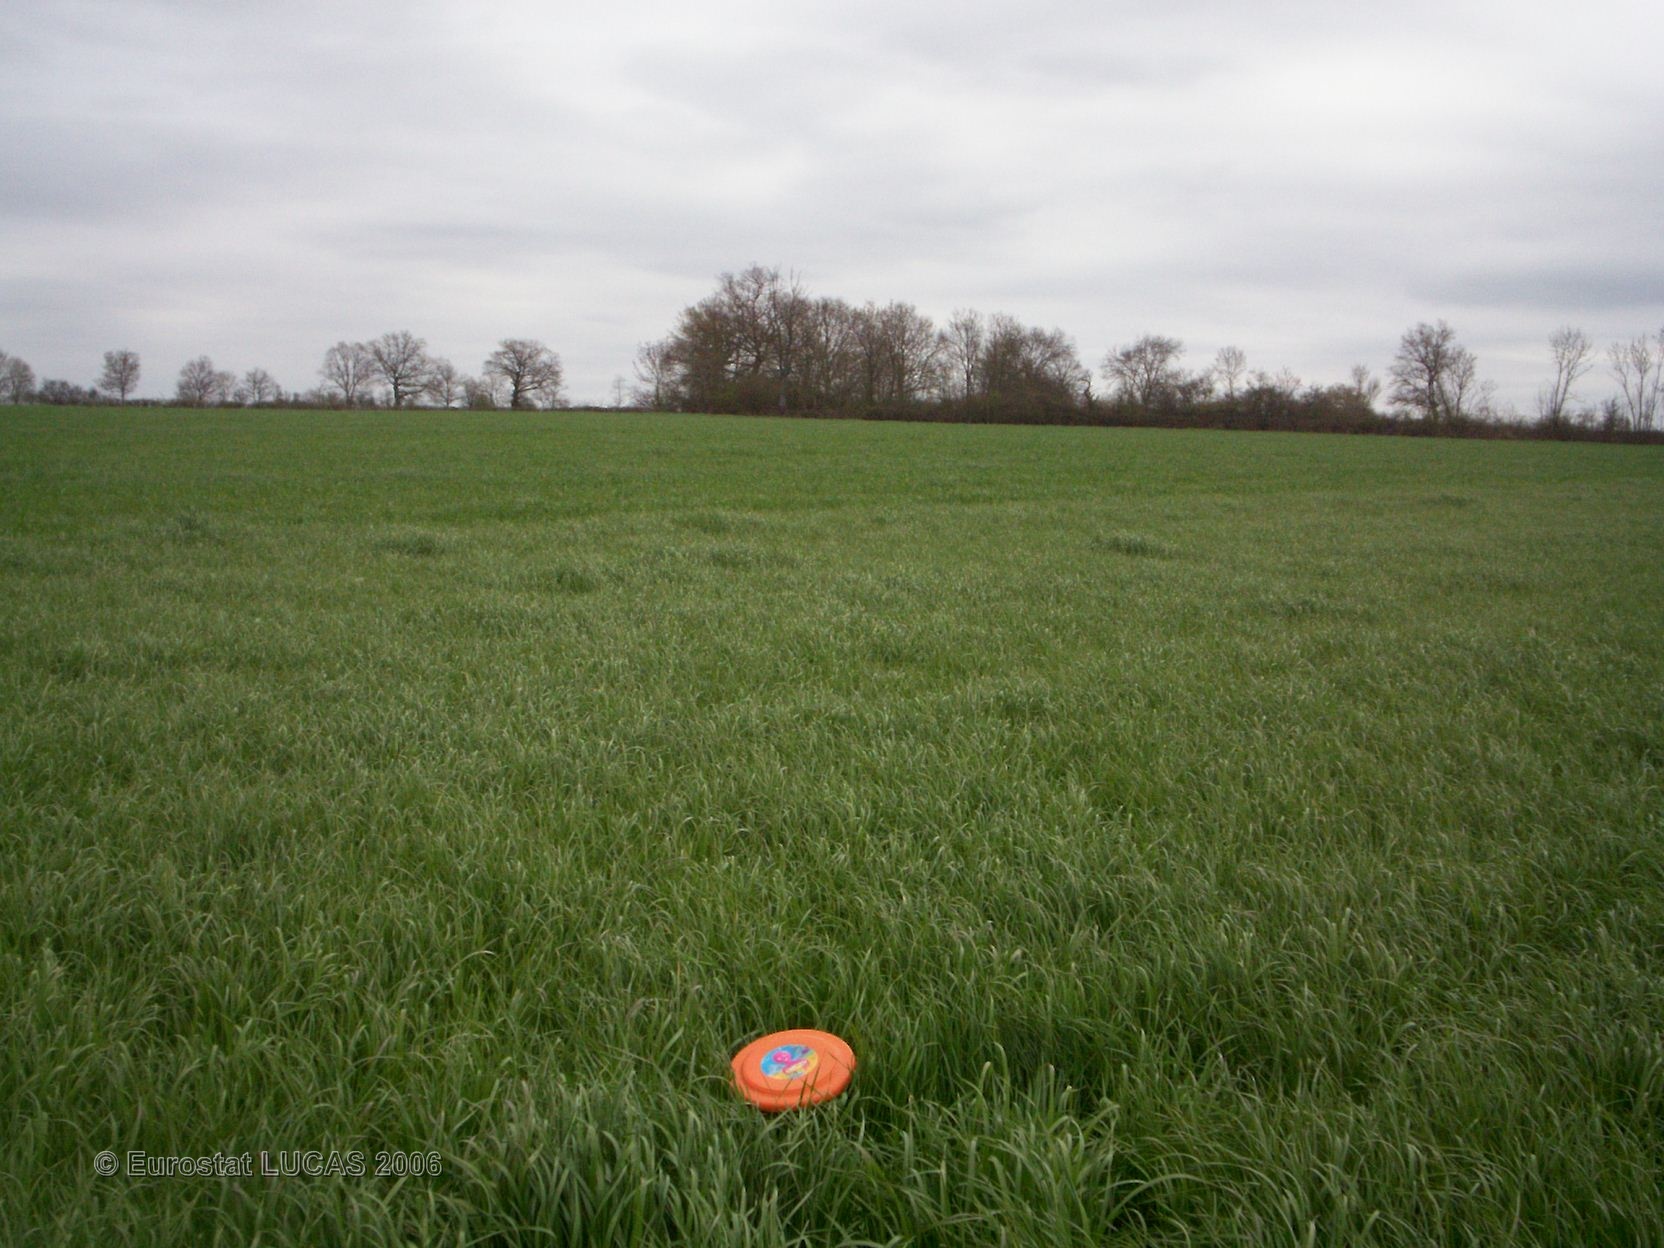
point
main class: Cropland
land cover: Barley
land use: Agriculture (excluding fallow land and kitchen gardens)
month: April
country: FR
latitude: 46.6677
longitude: 3.0564
